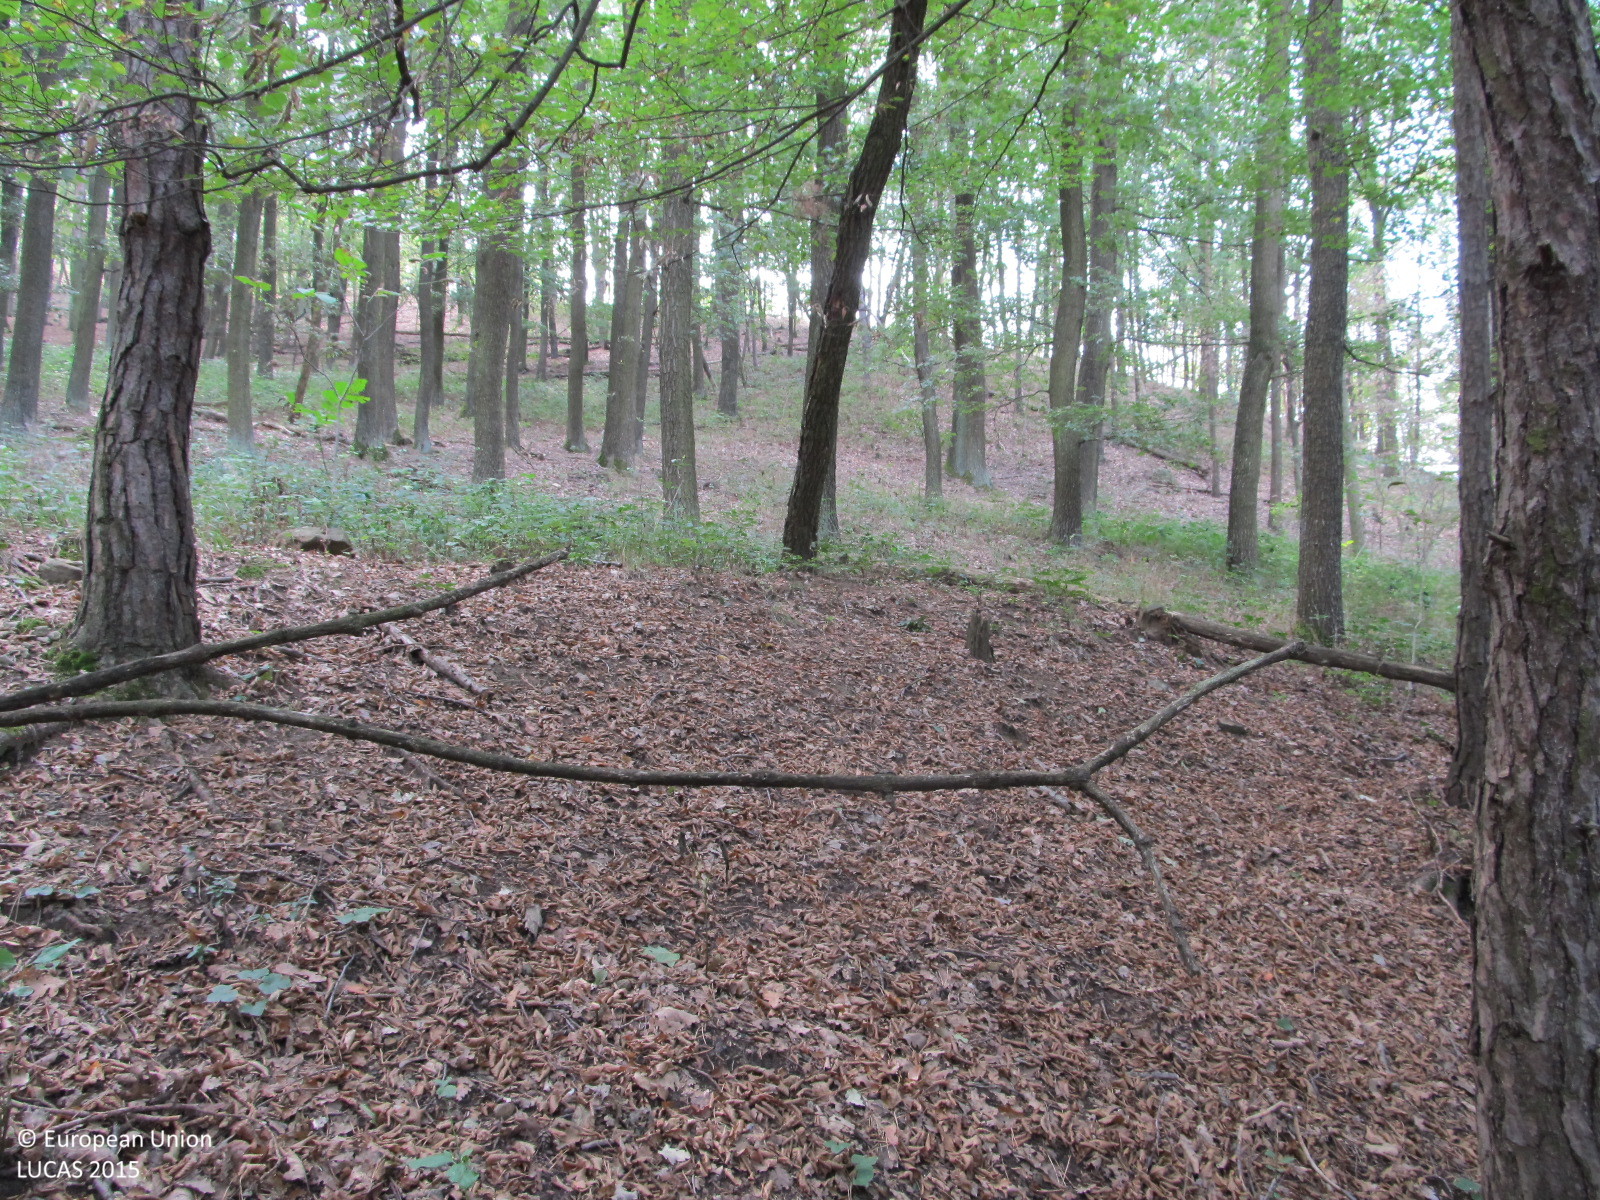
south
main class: Woodland
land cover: Other mixed woodland
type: hemiboreal forest and nemoral coniferous forest and mixed broadleaved-coniferous forest
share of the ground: > 75 %
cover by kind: broadleaved forest trees 60 %, coniferous forest trees 20 %, herbaceous plants 10 %, unconsolidated bare surface 10 %
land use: Forestry
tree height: > 5 m
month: September
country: AT
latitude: 48.3323
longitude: 15.6279
